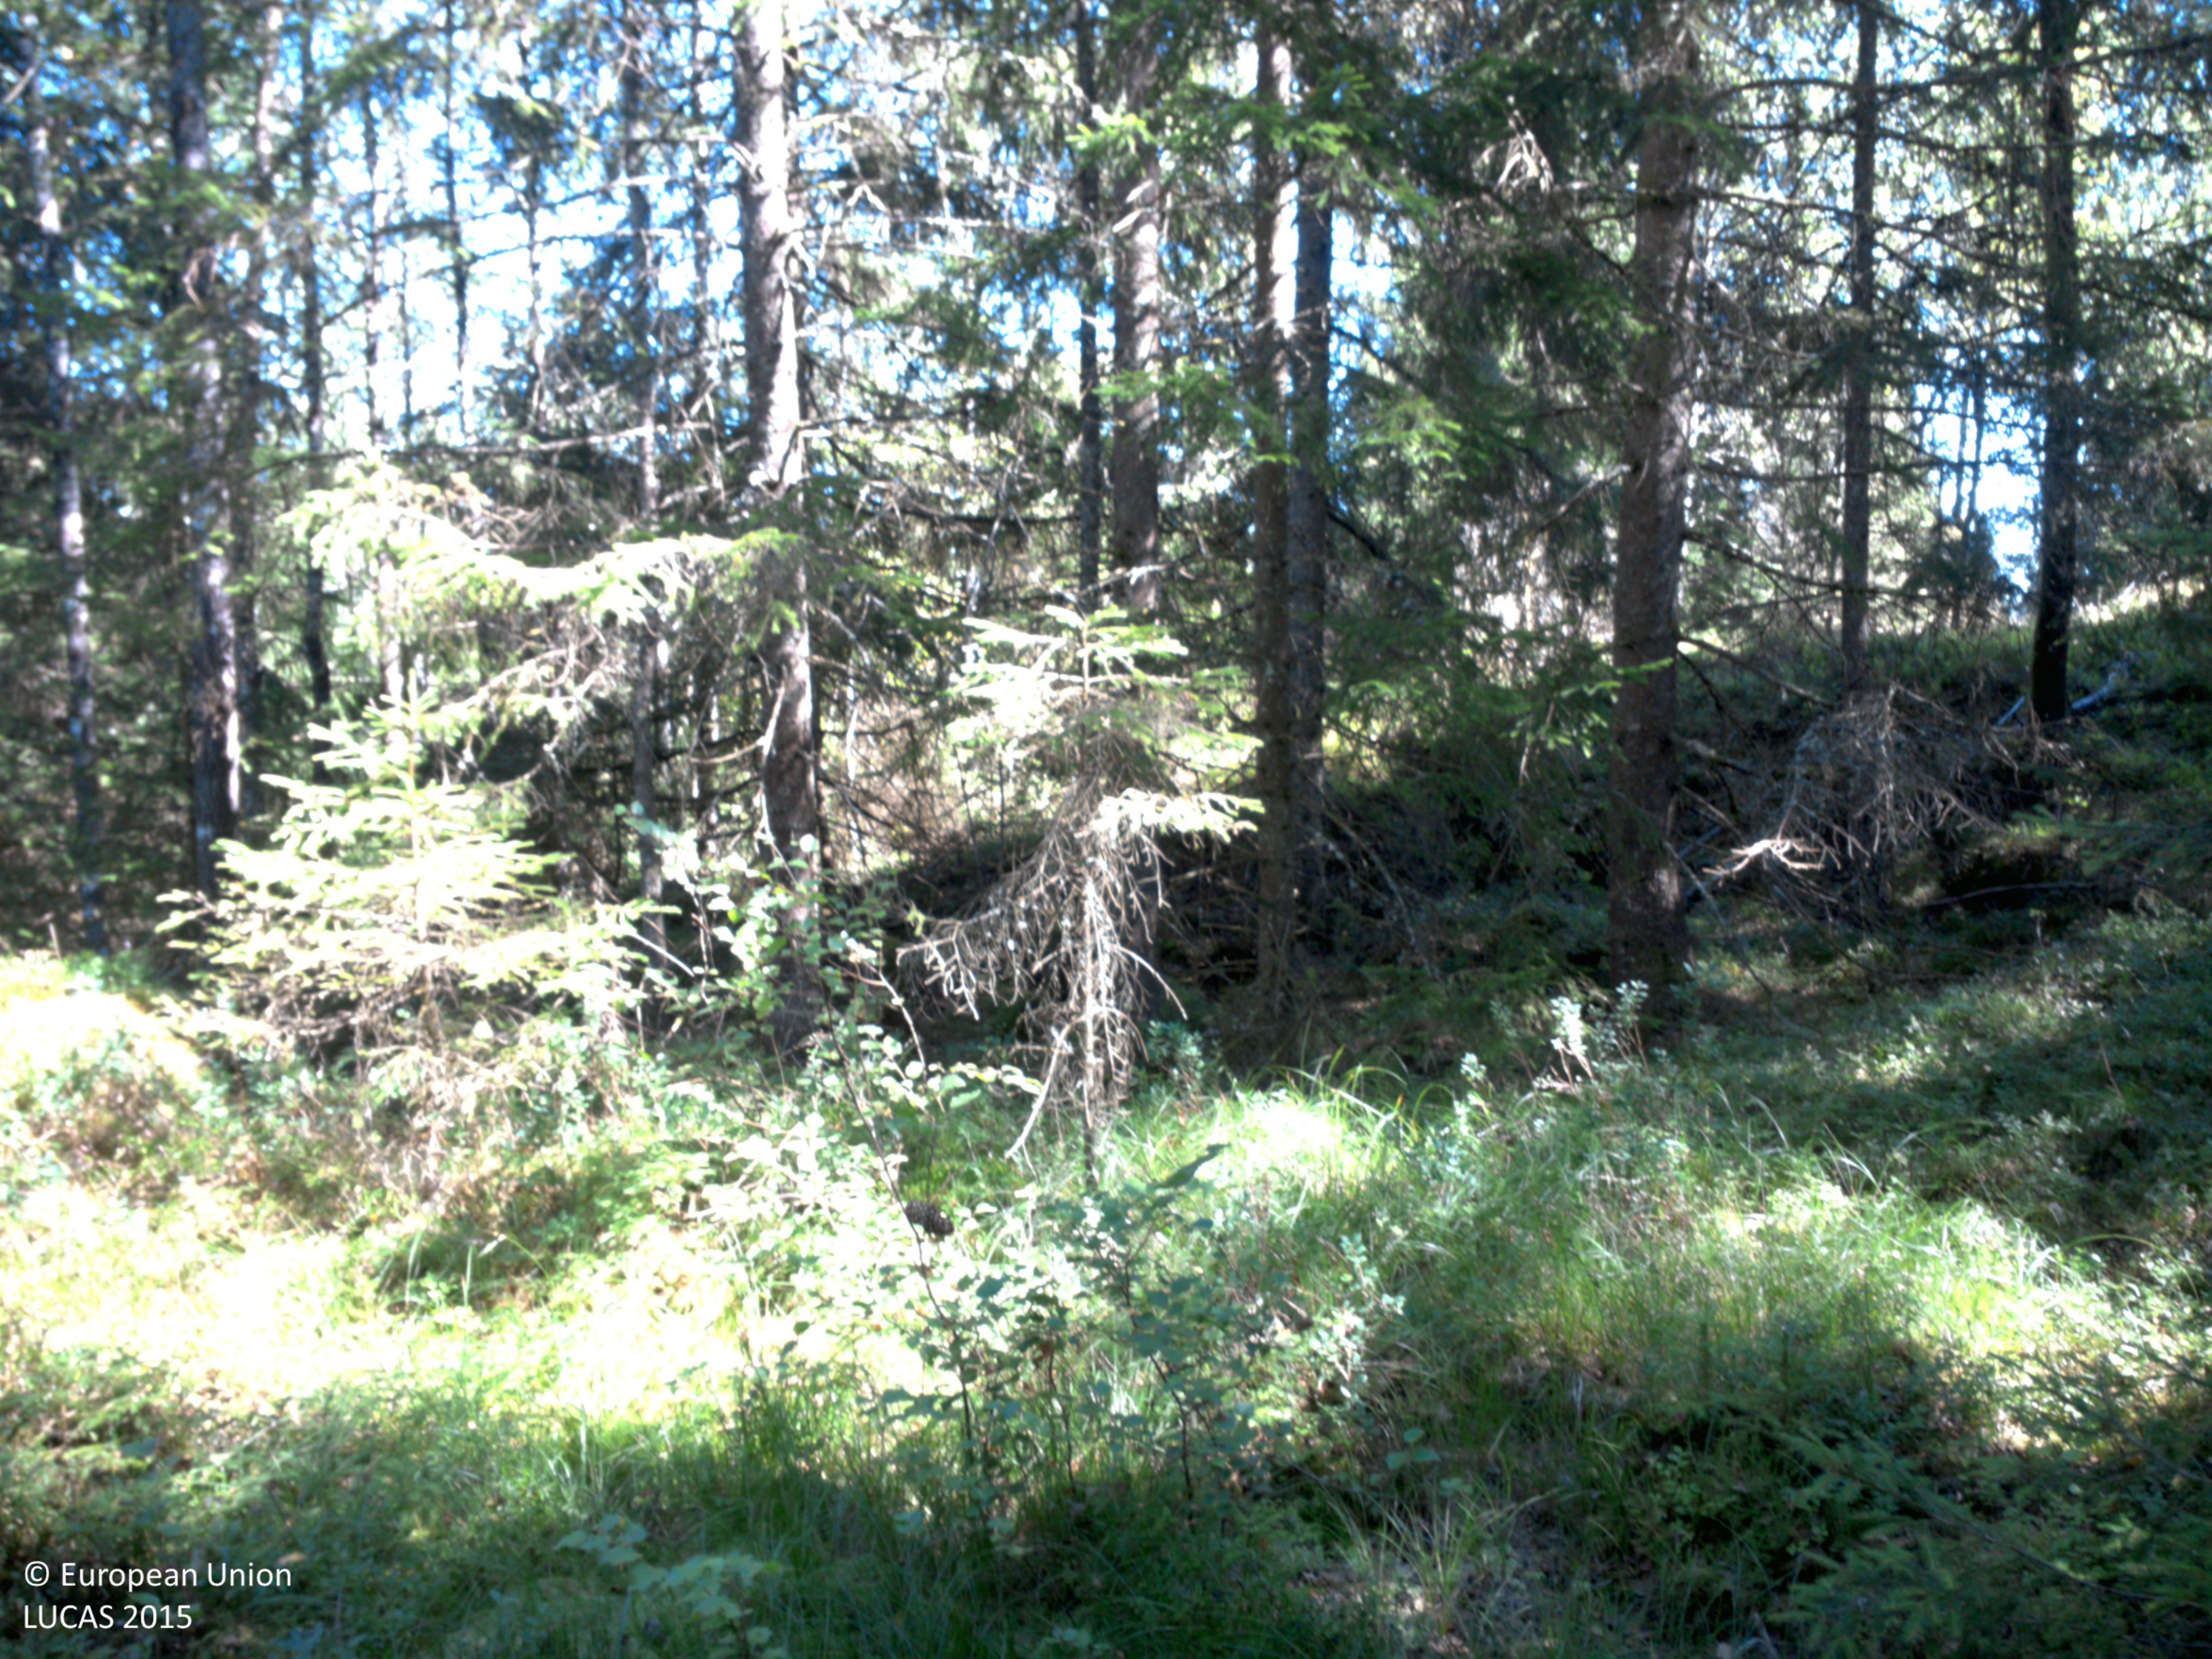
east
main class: Woodland
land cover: Spruce dominated mixed woodland
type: boreal forest
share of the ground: 50 - 75 %
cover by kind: coniferous forest trees 45 %, herbaceous plants 30 %, broadleaved forest trees 25 %
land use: Forestry
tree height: > 5 m
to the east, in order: Spruce dominated mixed woodland; Ditches and canals; Tracks; Ditches and canals; Spruce dominated mixed woodland; Spruce dominated coniferous woodland; Spruce dominated mixed woodland; Ditches and canals; Spruce dominated mixed woodland; Spruce dominated coniferous woodland; Tracks; Spruce dominated coniferous woodland
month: August
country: SE
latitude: 58.5474
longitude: 11.9375
